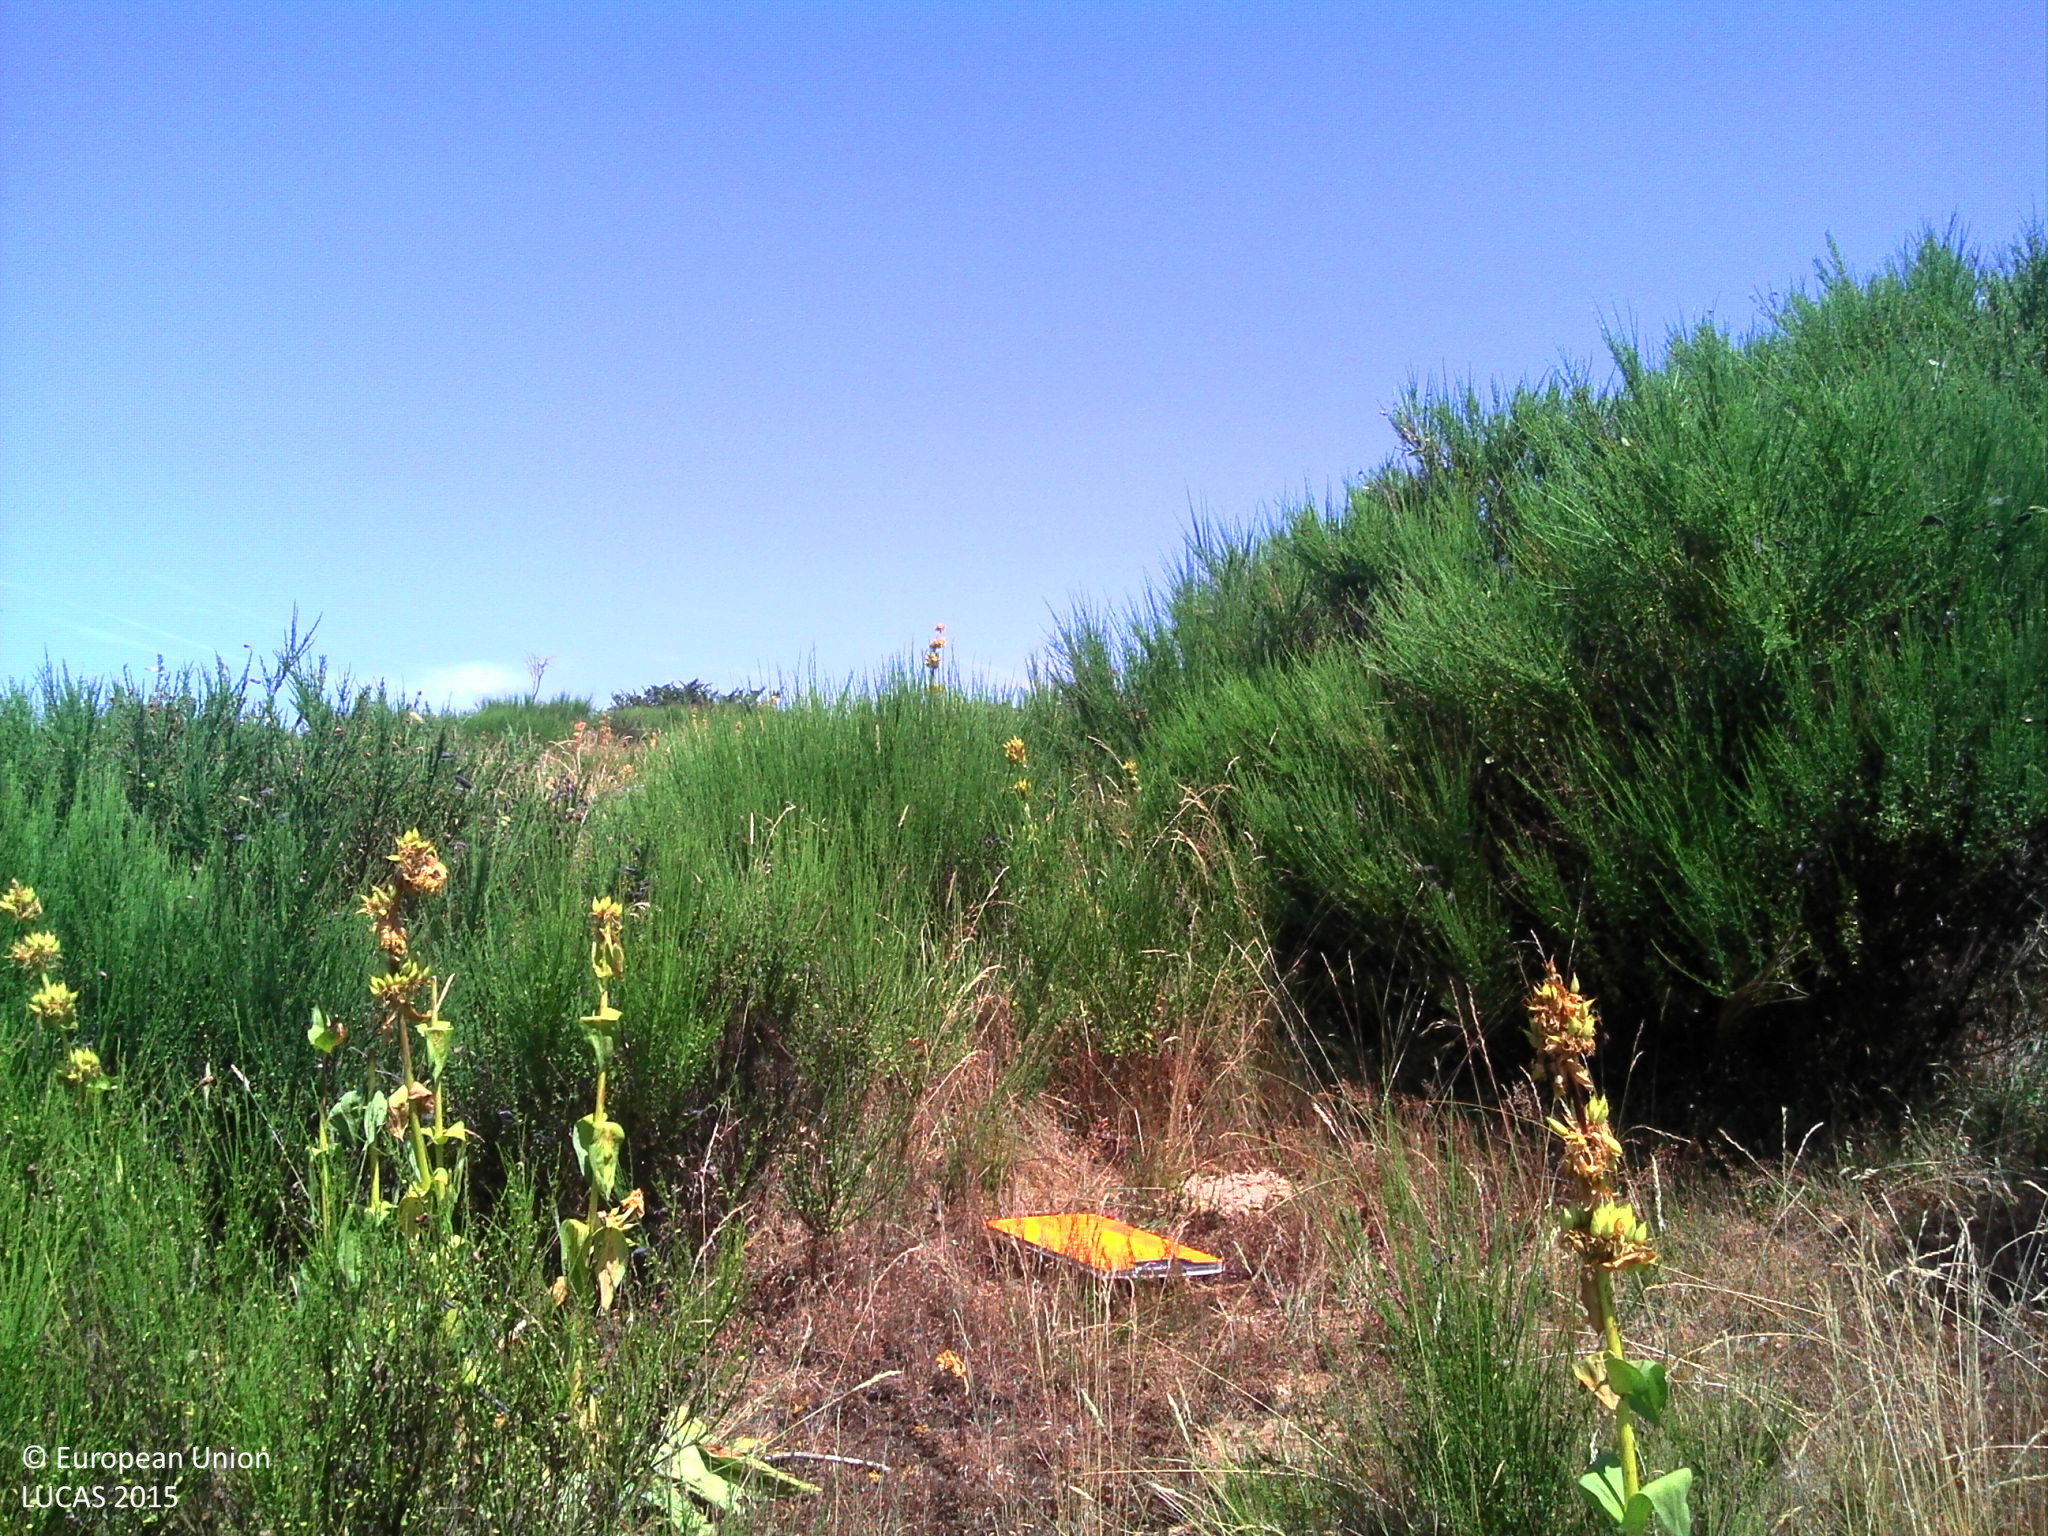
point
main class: Shrubland
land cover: Shrubland without tree cover
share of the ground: > 75 %
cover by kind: shrubs 90 %, herbaceous plants 10 %
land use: Agriculture (excluding fallow land and kitchen gardens)
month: July
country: FR
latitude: 44.6330
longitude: 3.1844
